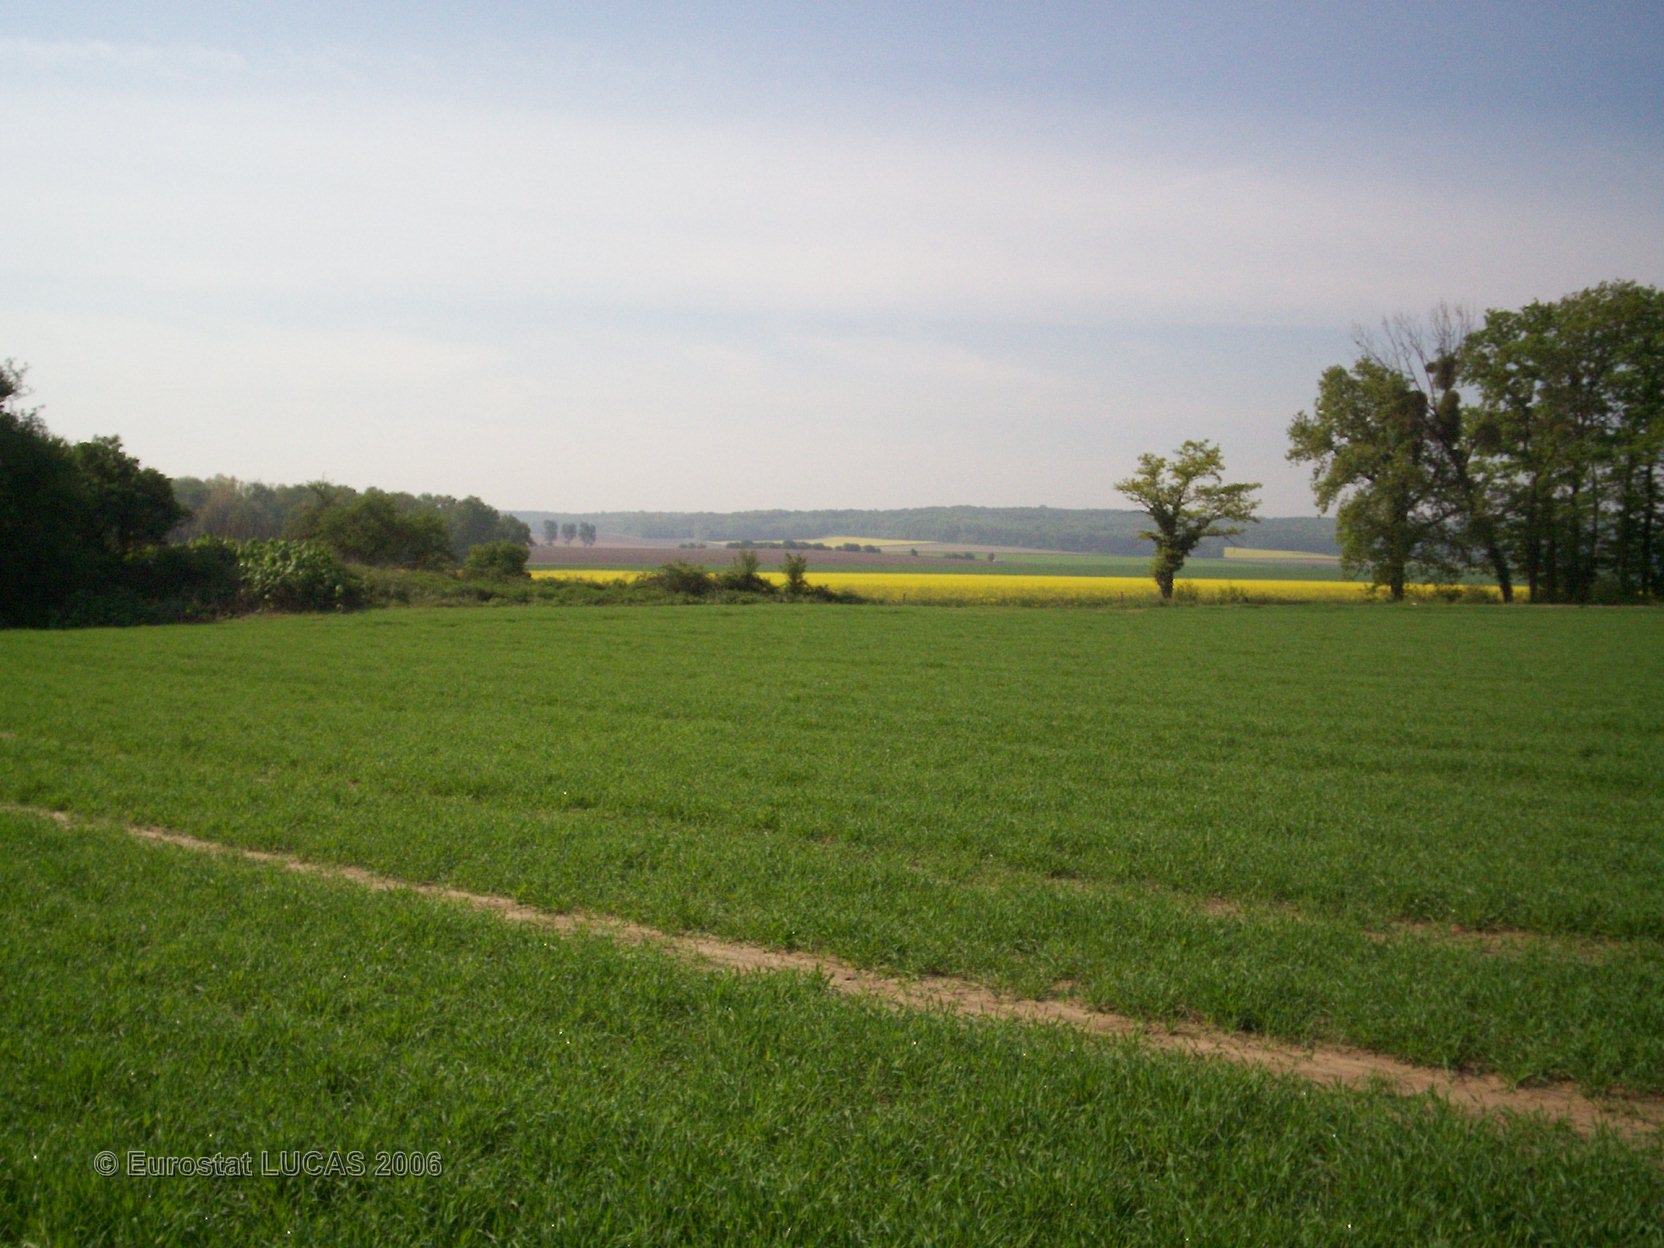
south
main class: Cropland
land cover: Barley
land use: Agriculture (excluding fallow land and kitchen gardens)
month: May
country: FR
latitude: 49.0523
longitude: 2.7789
